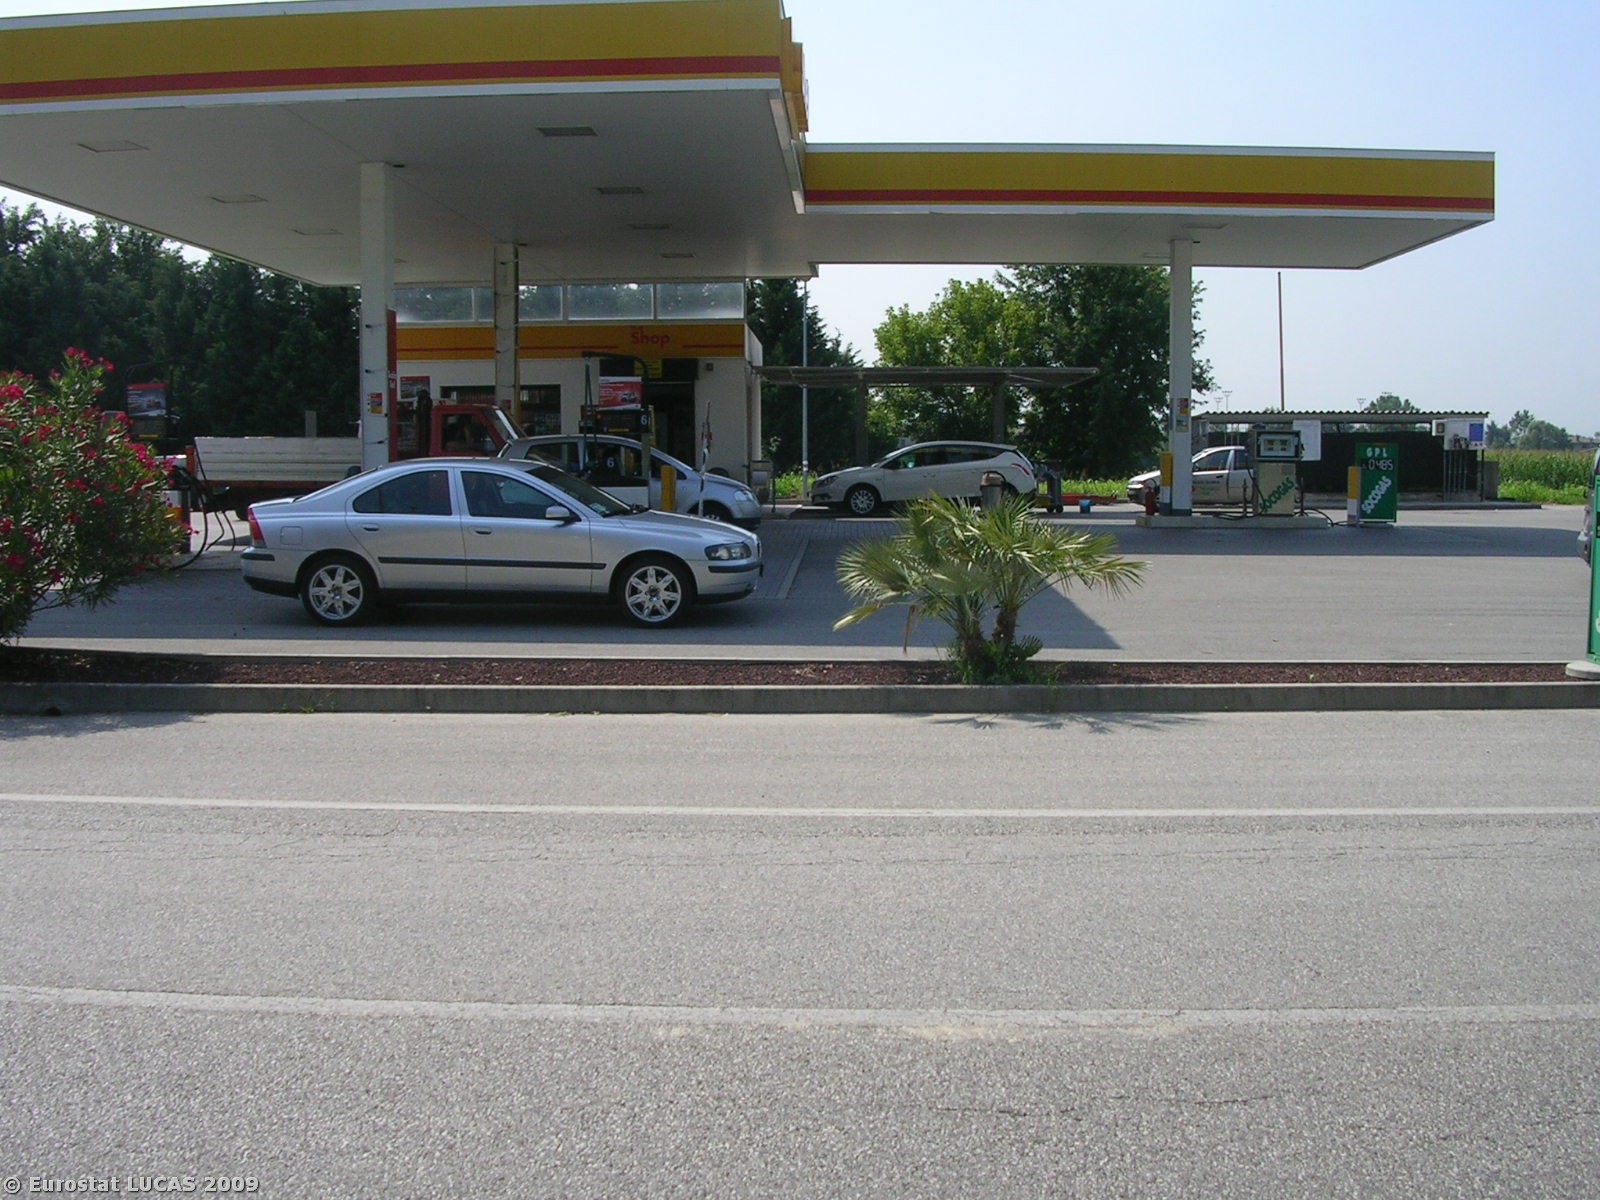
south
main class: Grassland
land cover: Grassland without tree/shrub cover
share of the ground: > 75 %
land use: Agriculture (excluding fallow land and kitchen gardens)
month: July
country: IT
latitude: 45.4899
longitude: 11.7501
